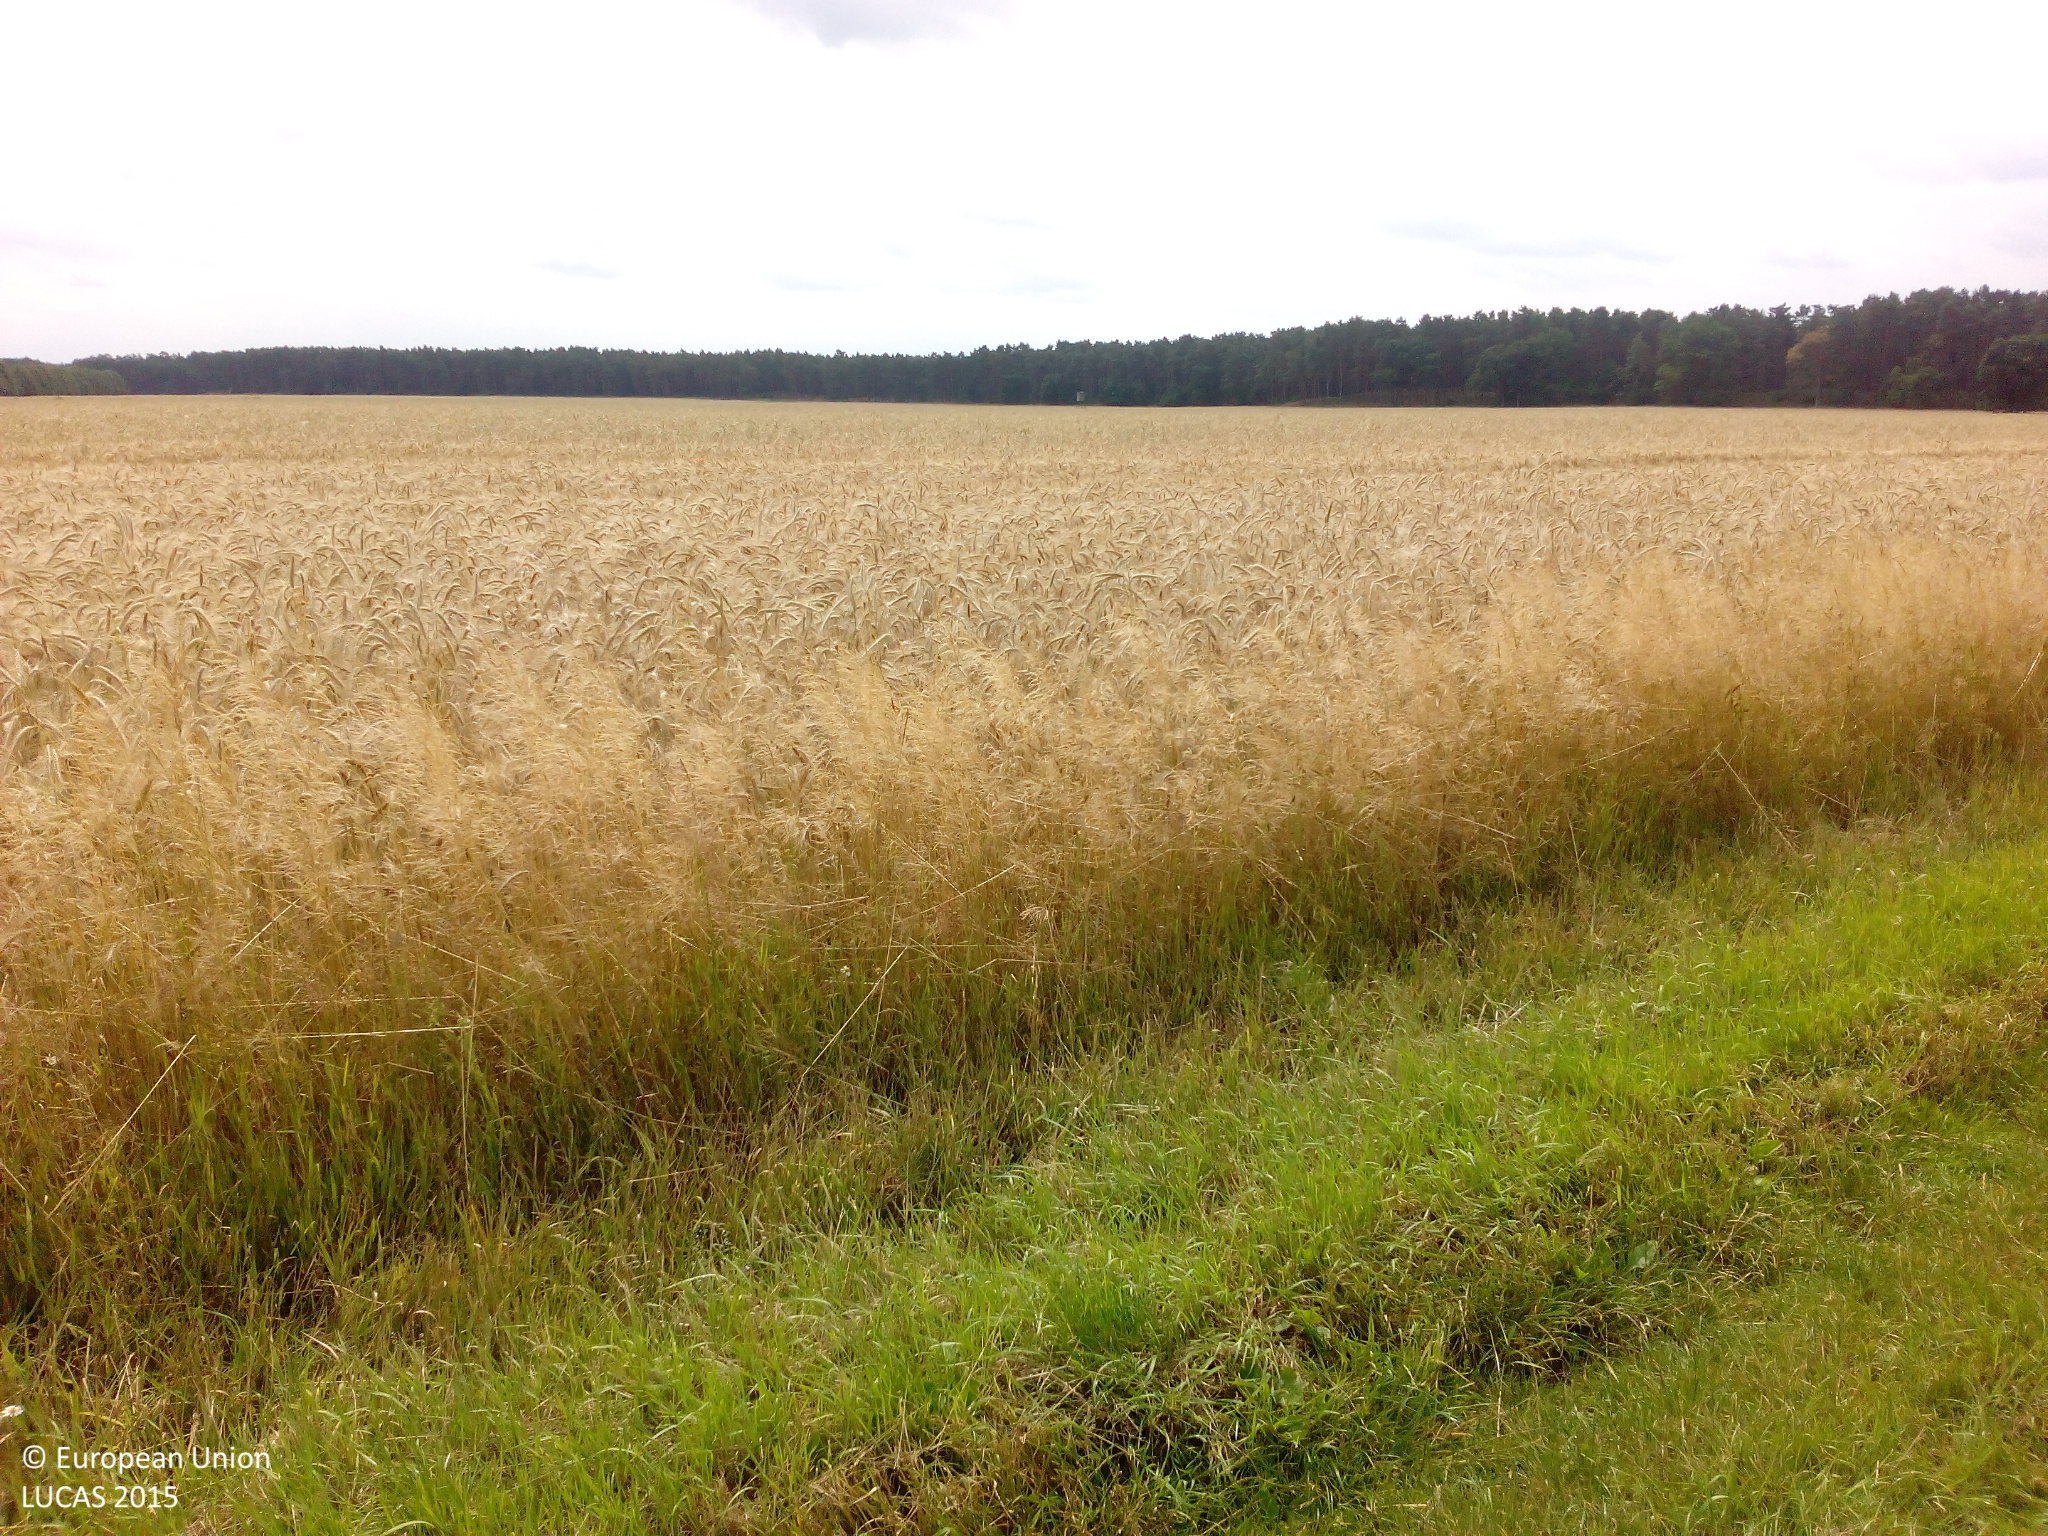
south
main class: Cropland
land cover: Barley
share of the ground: > 75 %
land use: Agriculture (excluding fallow land and kitchen gardens)
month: July
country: DE
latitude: 53.1233
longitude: 11.4788
